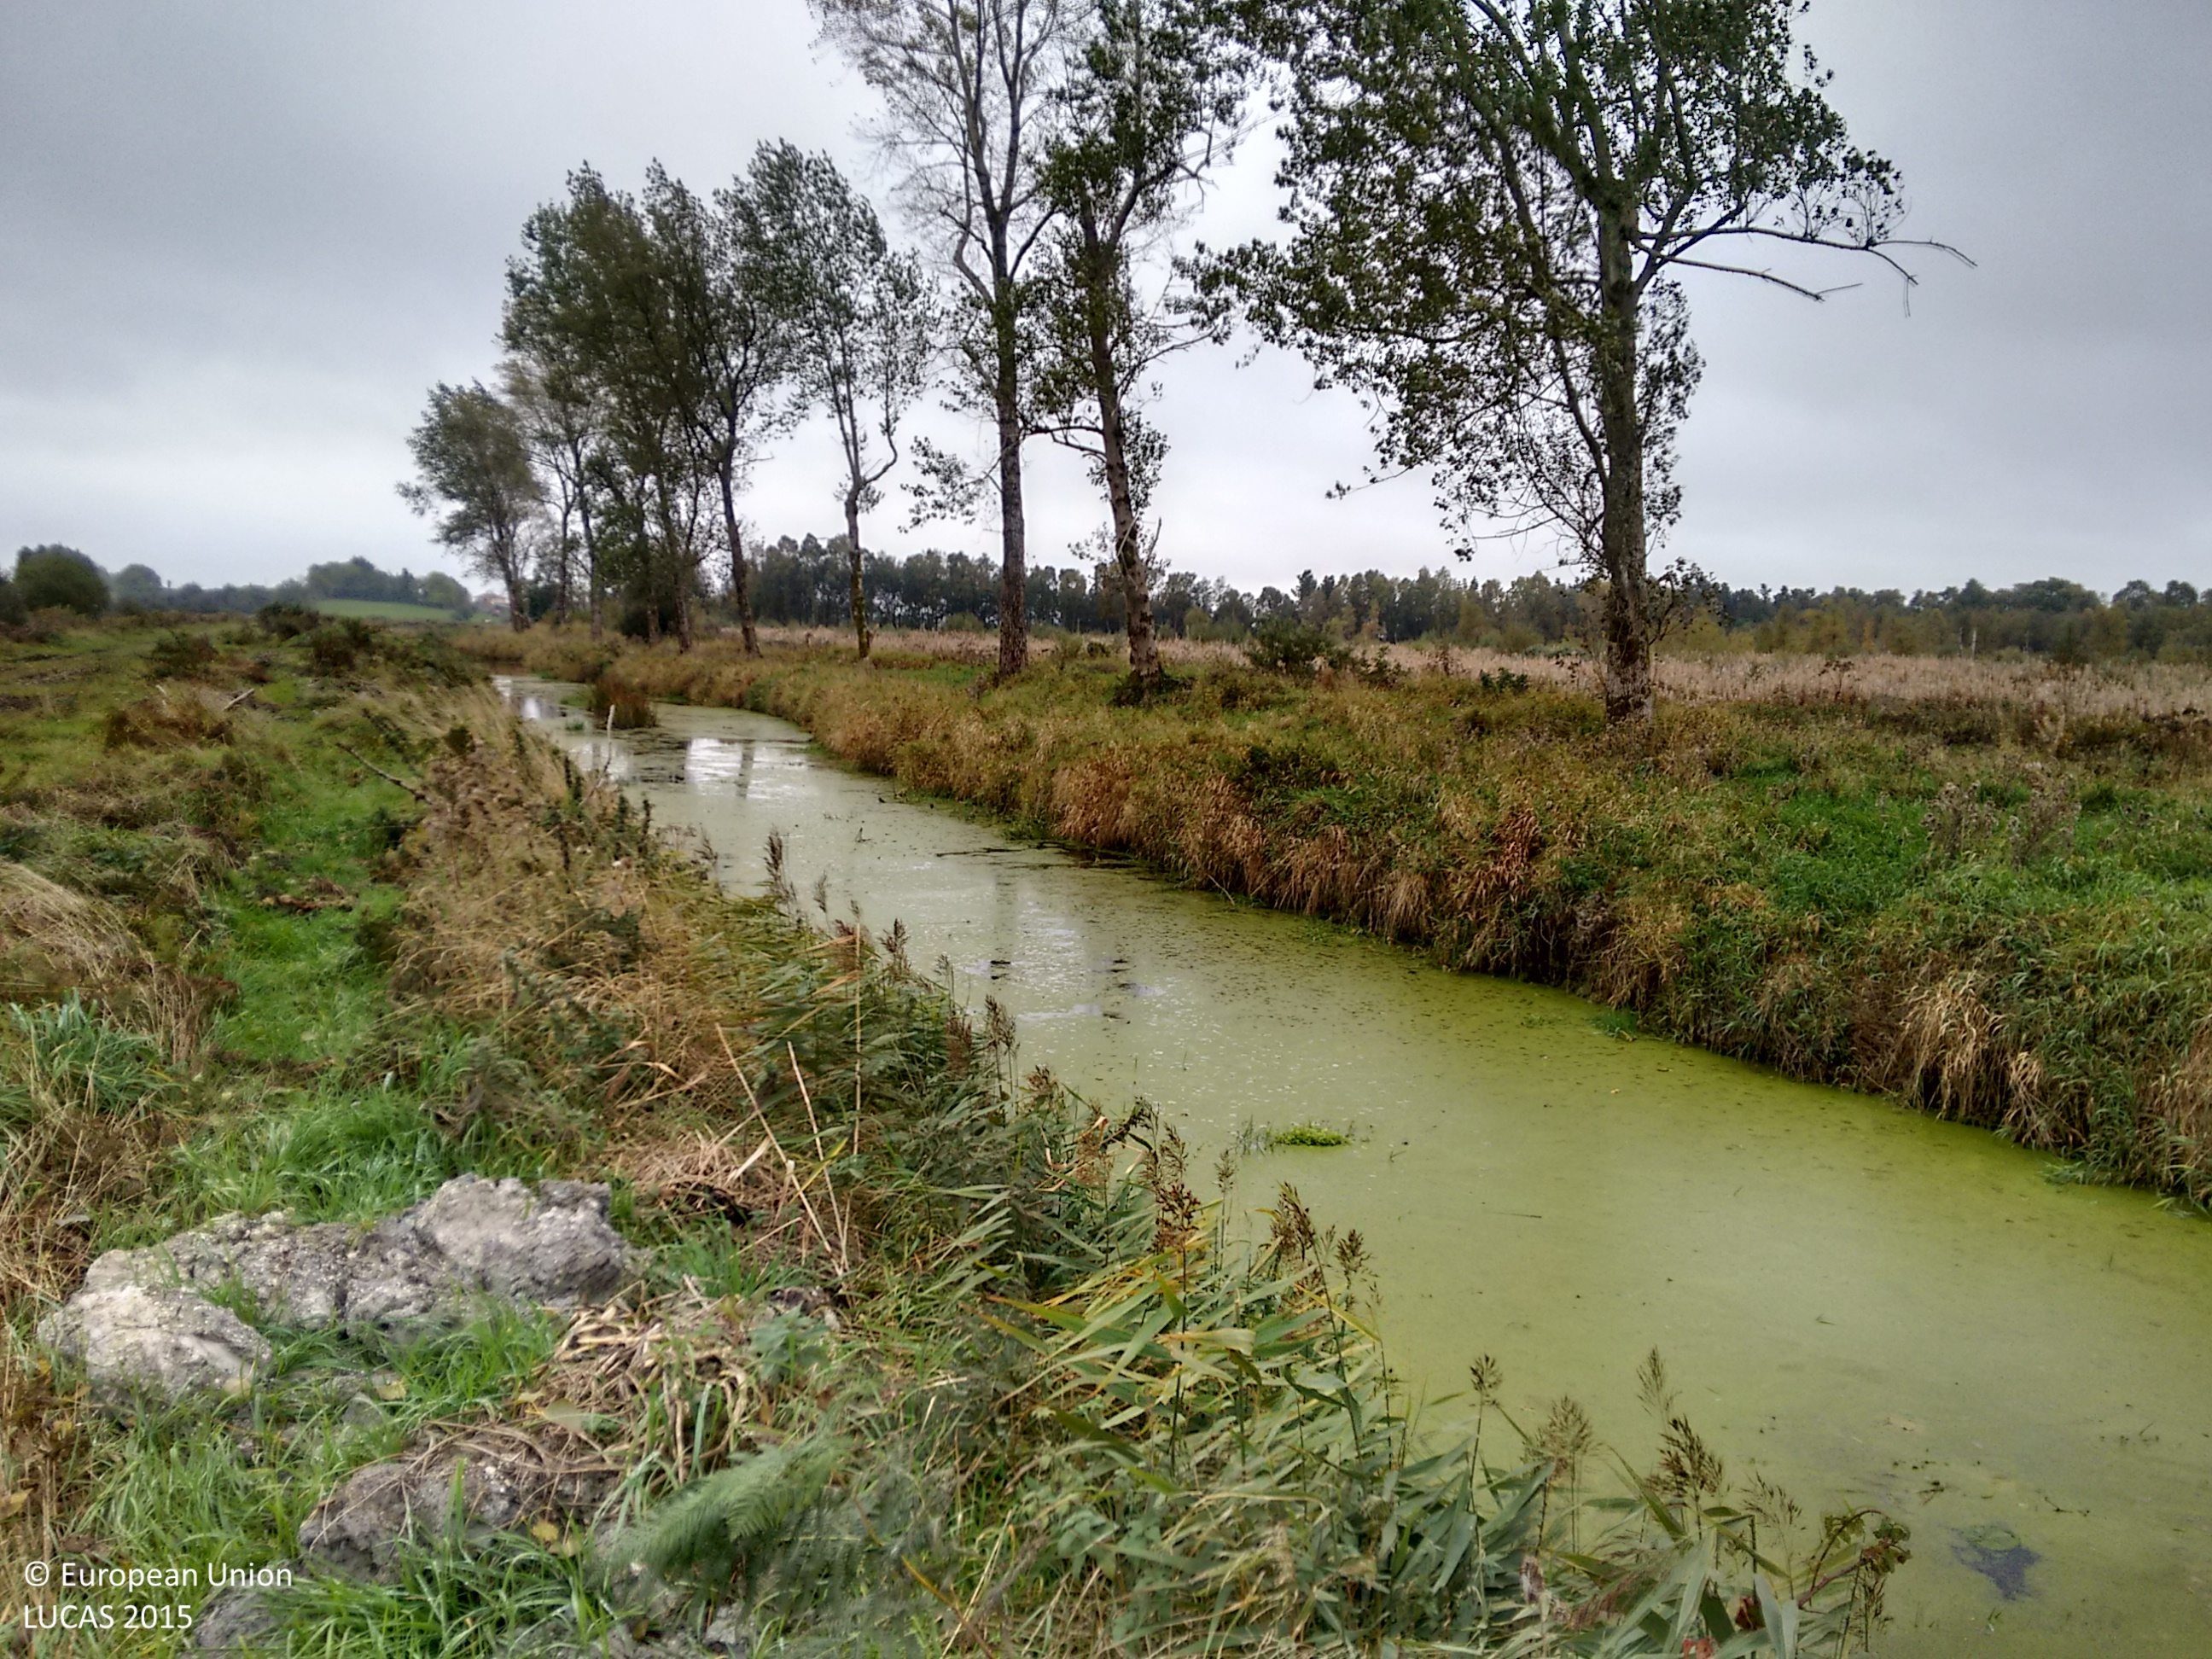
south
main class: Grassland
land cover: Grassland without tree/shrub cover
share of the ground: > 75 %
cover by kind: herbaceous plants 100 %
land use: Semi-natural and natural areas not in use
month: October
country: IE
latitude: 52.7171
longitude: -7.6472
